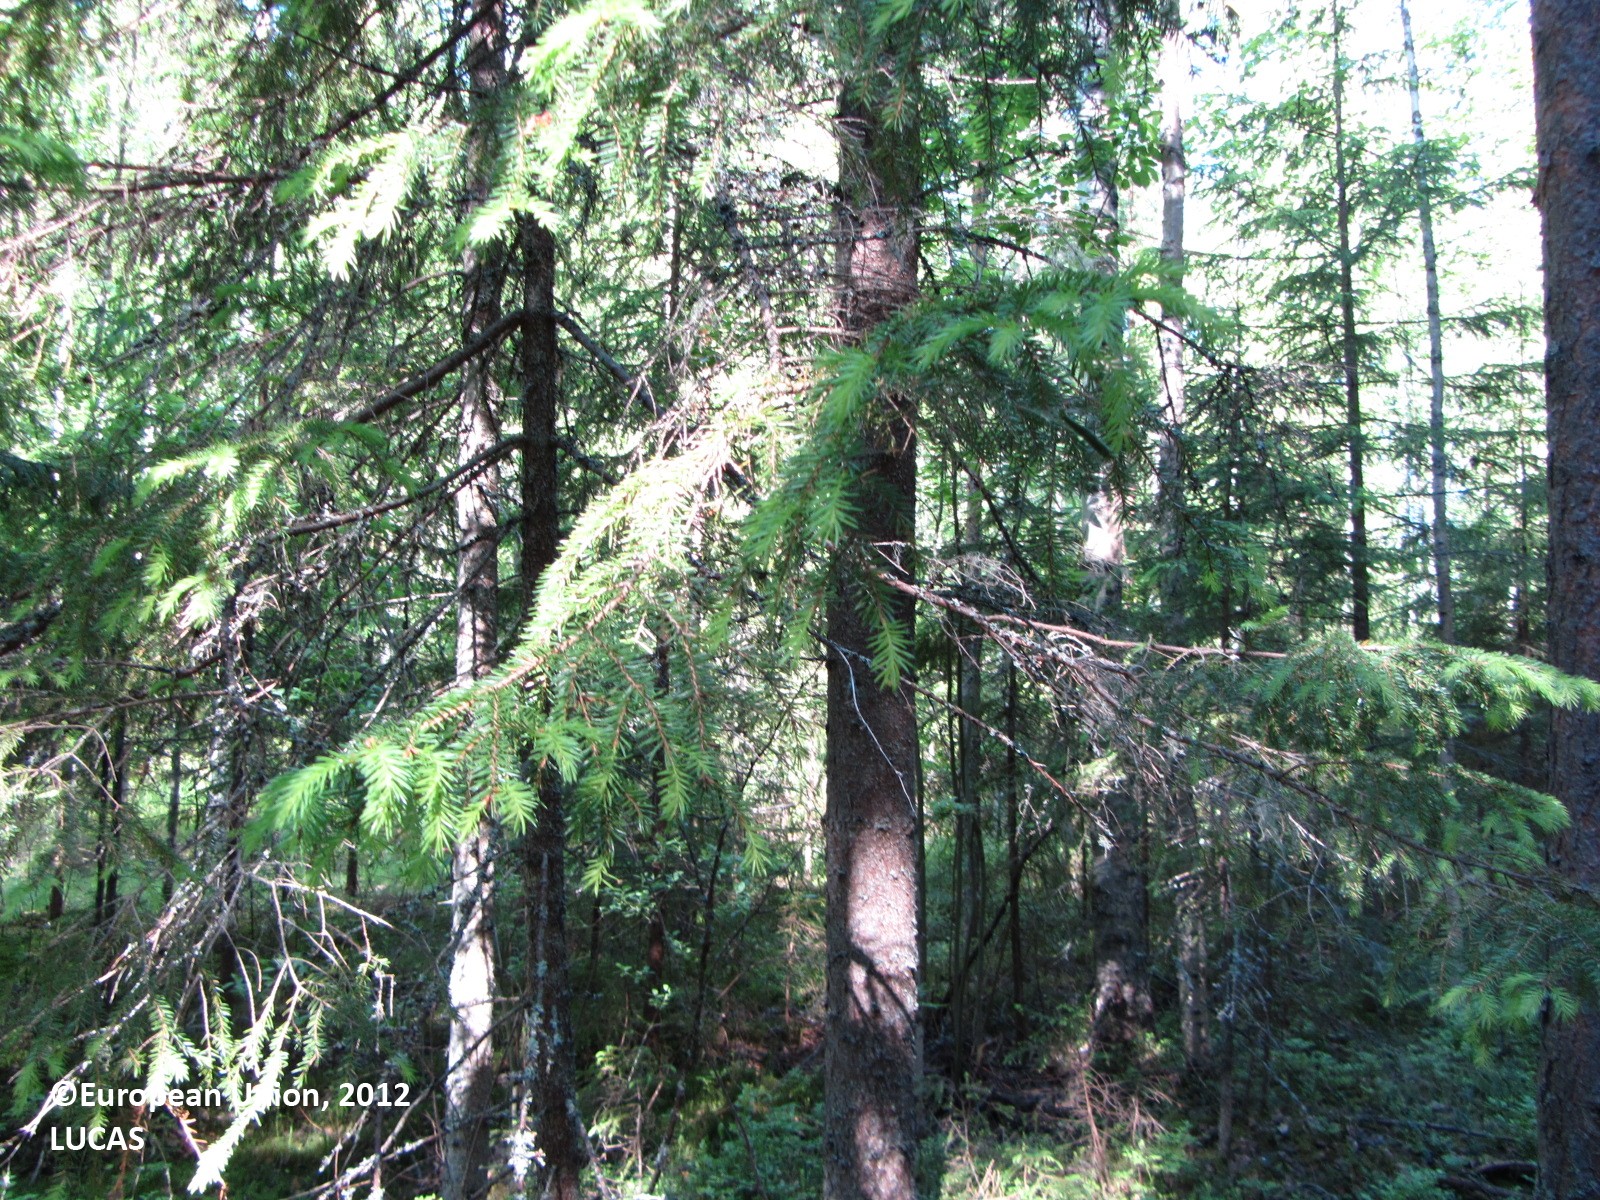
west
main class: Woodland
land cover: Spruce dominated coniferous woodland
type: boreal forest
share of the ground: 50 - 75 %
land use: Forestry
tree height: > 5 m
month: June
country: FI
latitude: 61.9639
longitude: 24.6490
